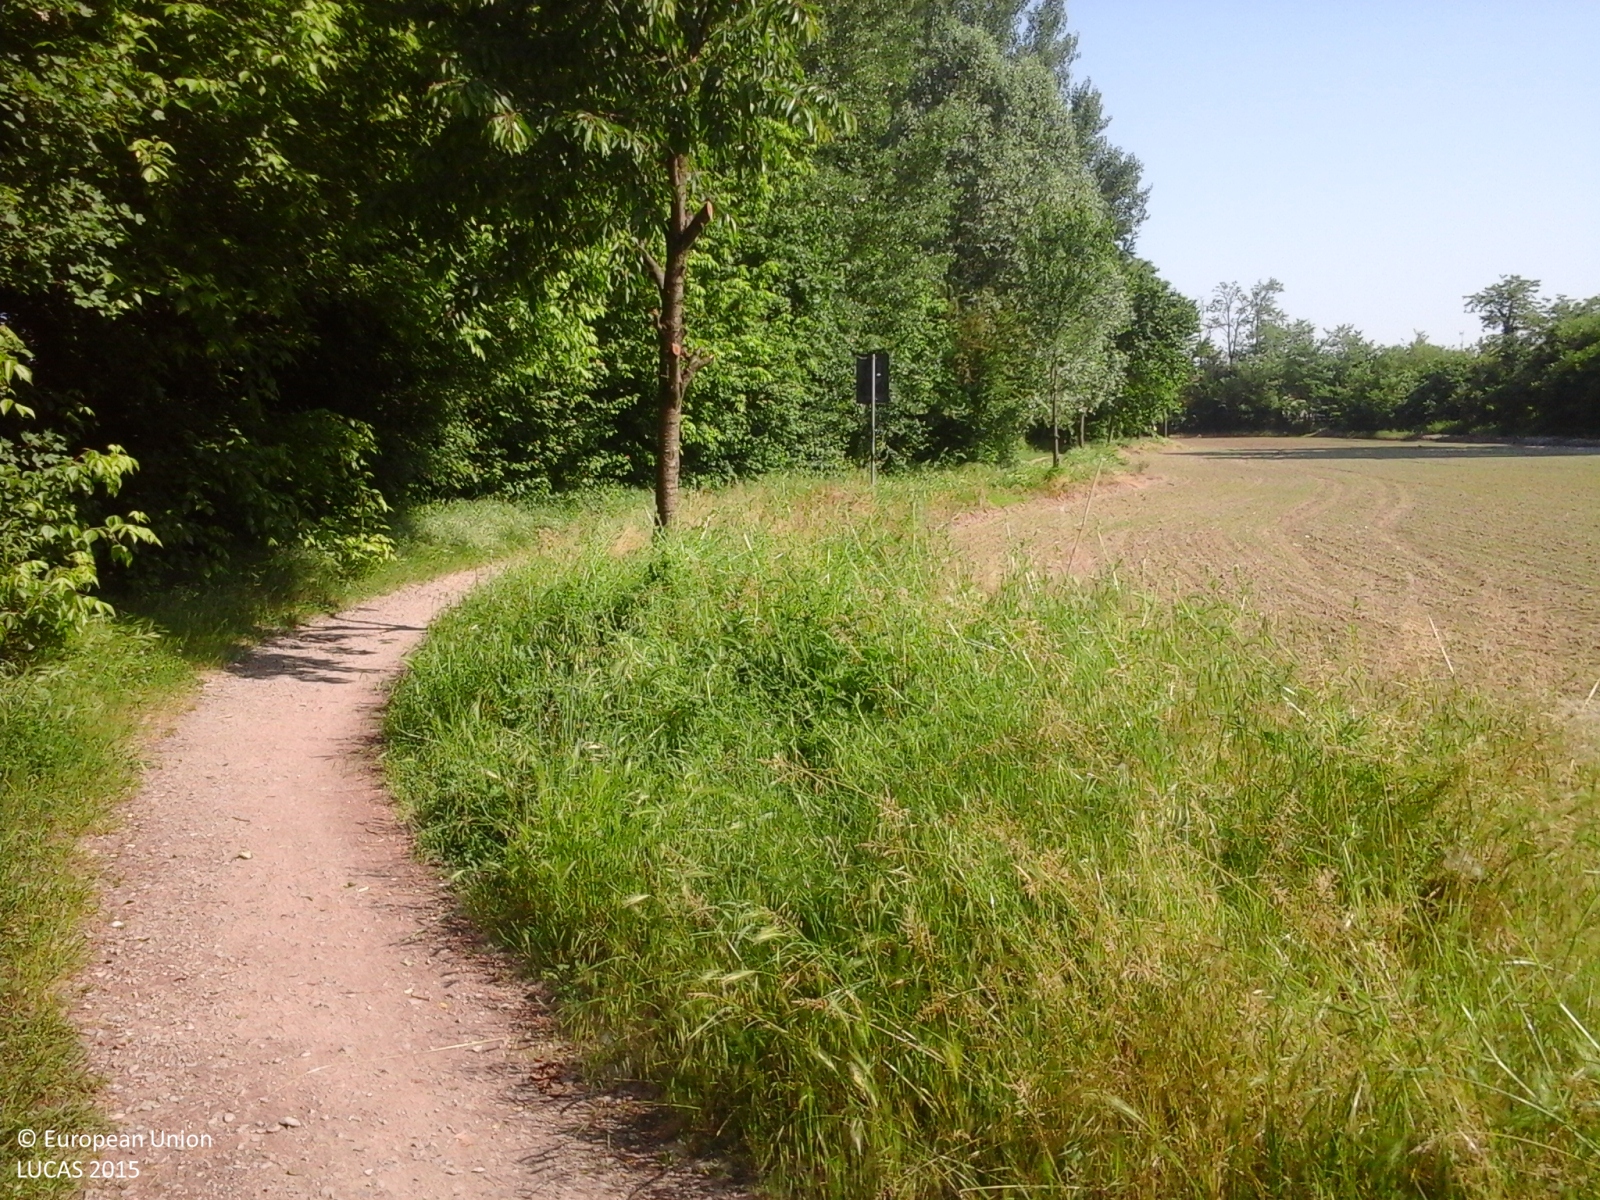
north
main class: Shrubland
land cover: Shrubland with sparse tree cover
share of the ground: > 75 %
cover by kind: shrubs 70 %, herbaceous plants 25 %, broadleaved forest trees 5 %
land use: Semi-natural and natural areas not in use
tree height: > 5 m
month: May
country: IT
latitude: 45.2308
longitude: 9.1736
